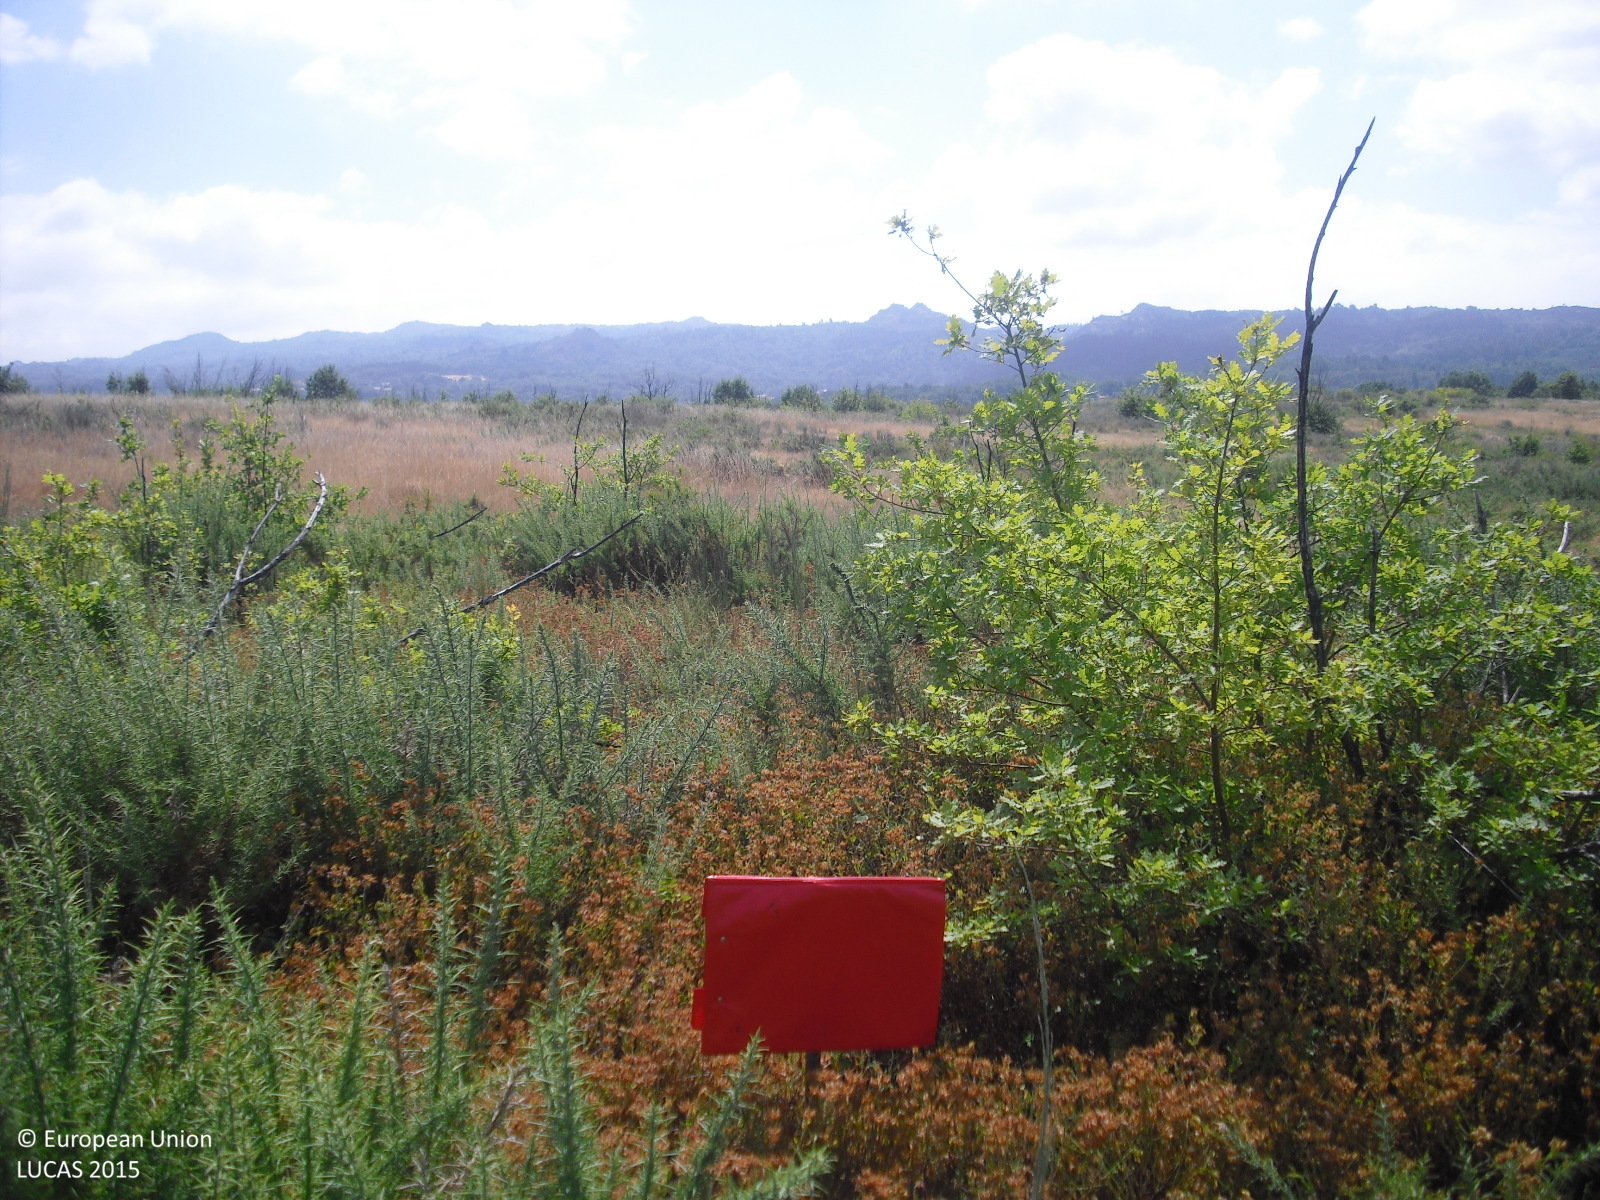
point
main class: Shrubland
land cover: Shrubland with sparse tree cover
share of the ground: > 75 %
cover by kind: shrubs 80 %, herbaceous plants 15 %, broadleaved forest trees 5 %
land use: Abandoned areas
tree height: < 5 m
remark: Burnt area
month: July
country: ES
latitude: 42.3600
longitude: -7.7647
